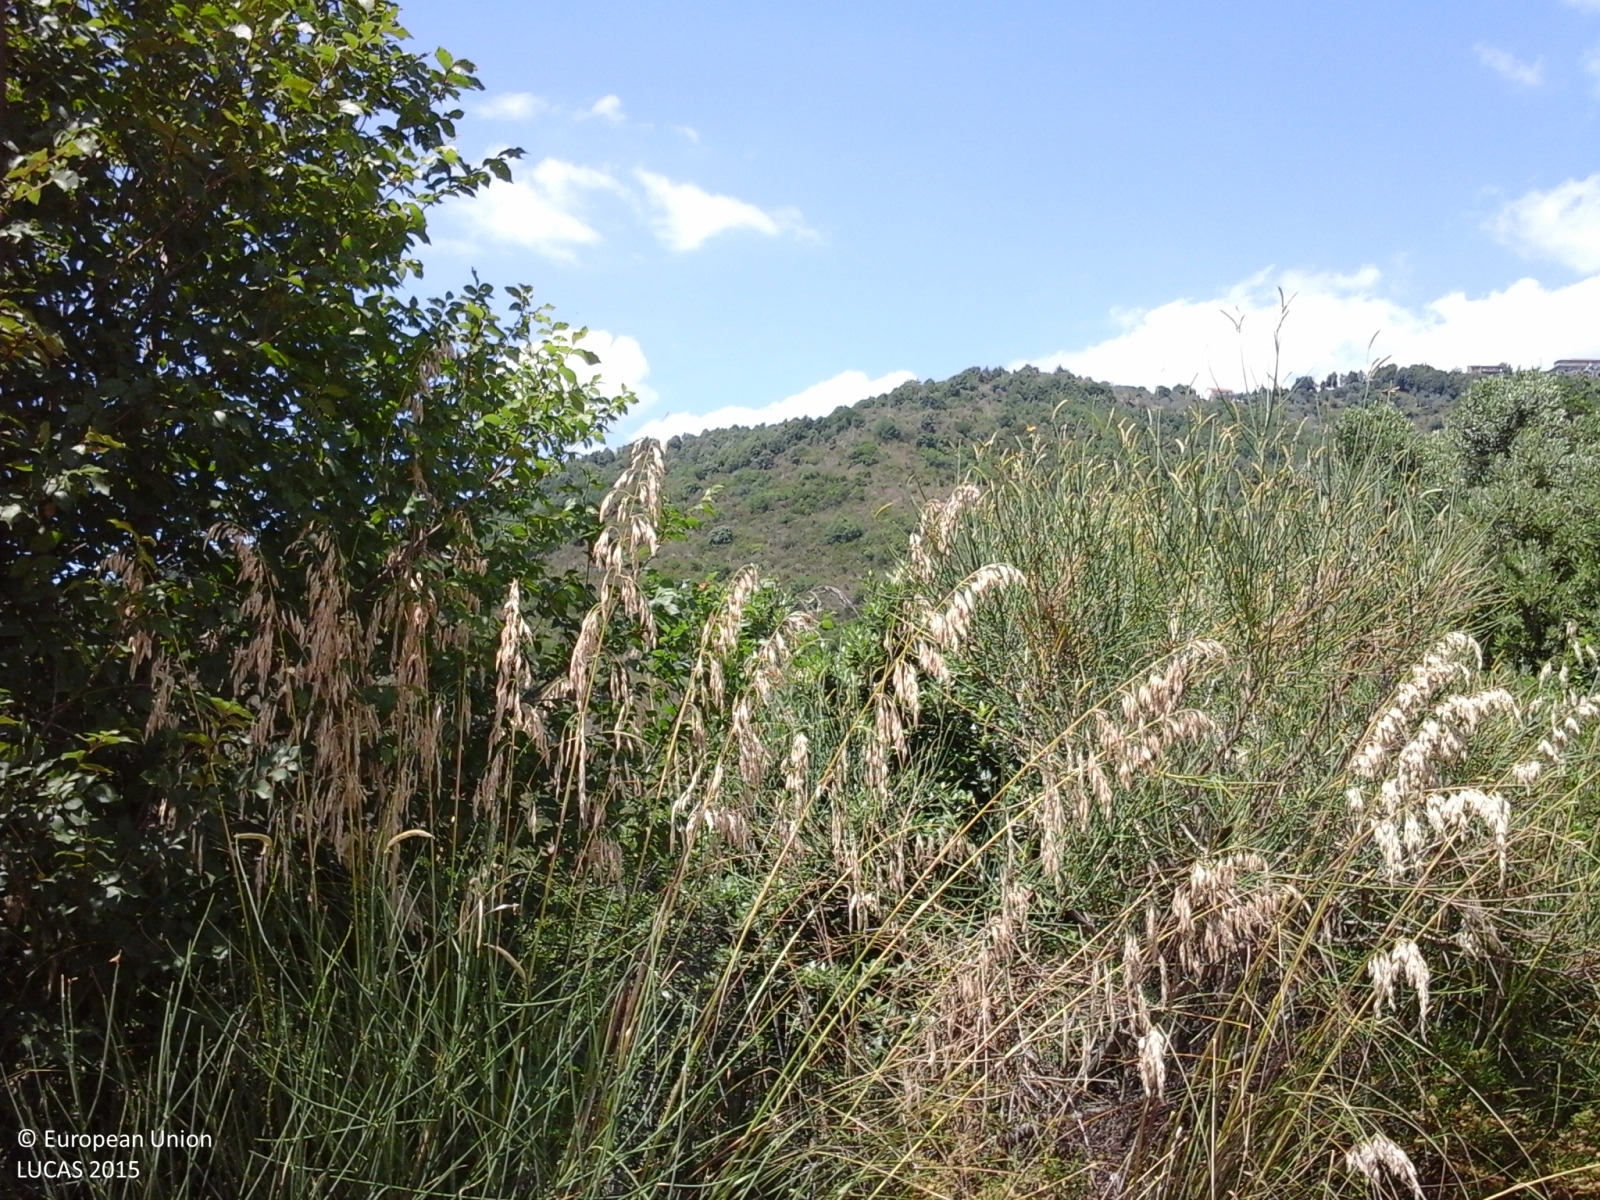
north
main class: Shrubland
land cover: Shrubland with sparse tree cover
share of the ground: > 75 %
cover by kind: shrubs 85 %, broadleaved forest trees 5 %
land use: Semi-natural and natural areas not in use
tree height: > 5 m
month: June
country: IT
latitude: 40.3342
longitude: 15.0981
